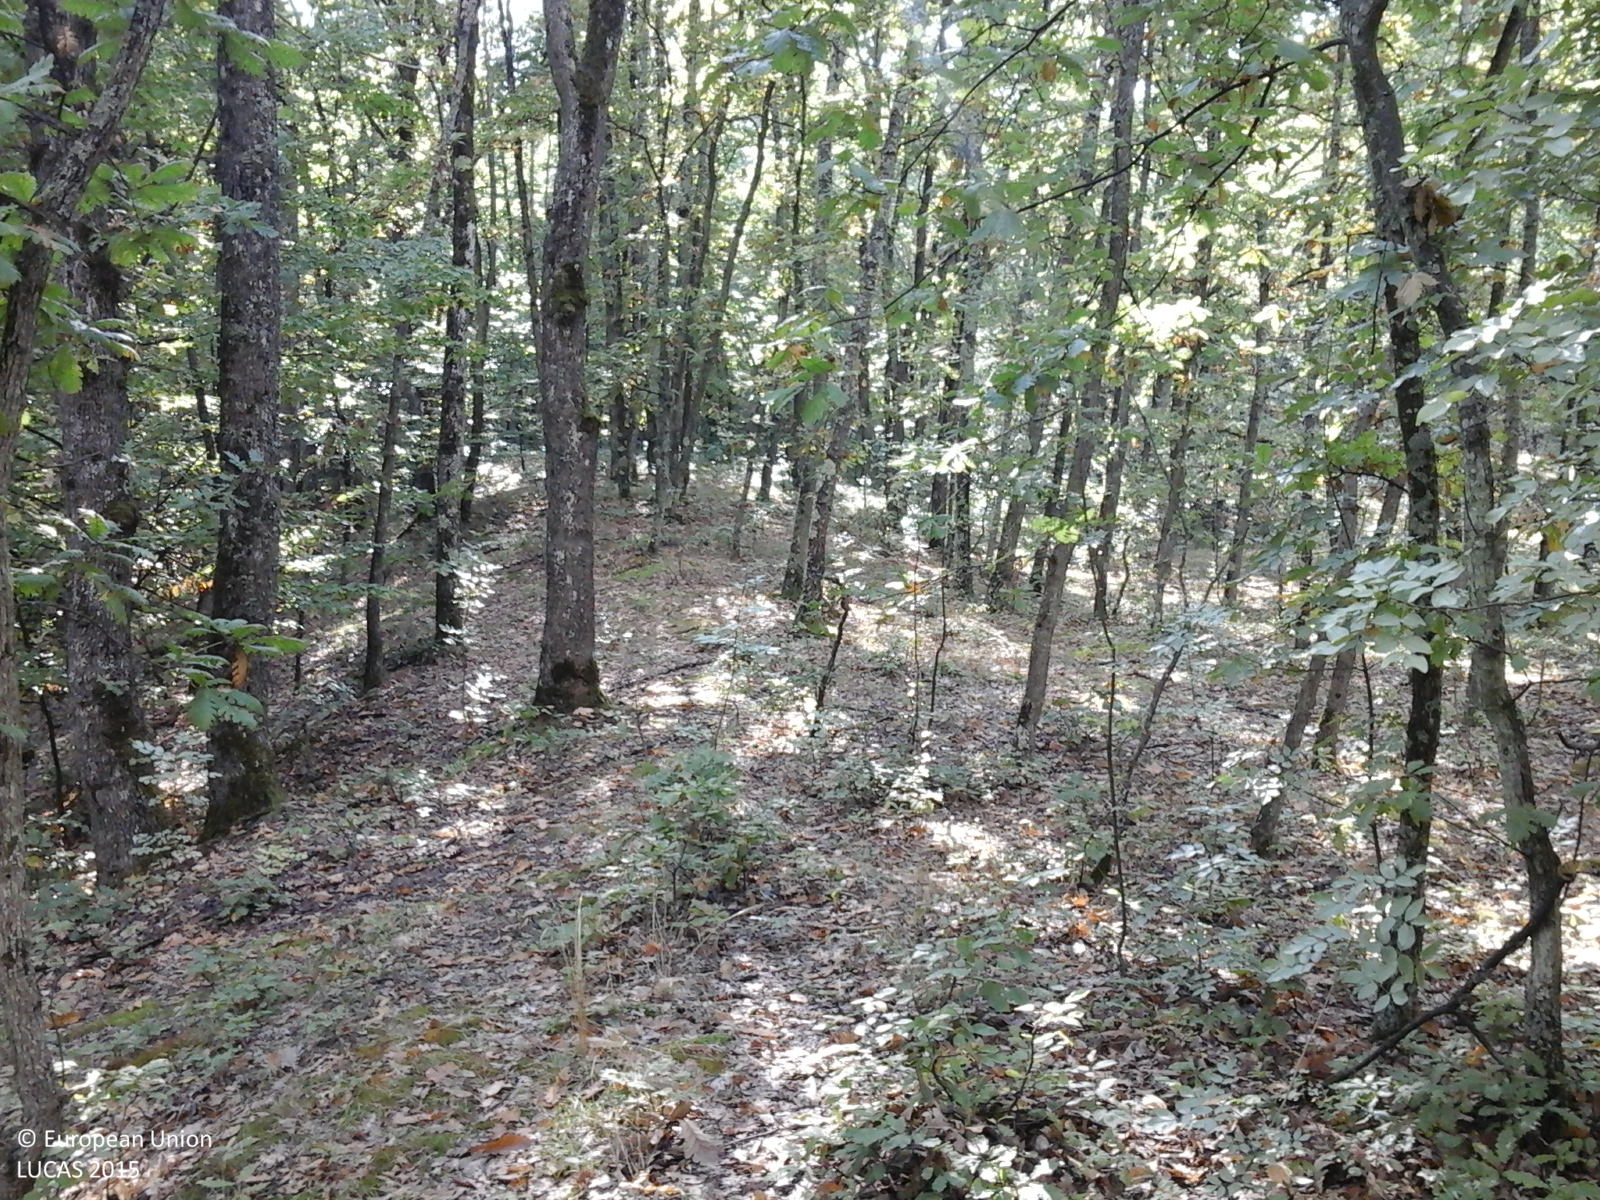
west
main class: Woodland
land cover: Broadleaved woodland
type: acidophilous oak and oak-birch forest
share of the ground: > 75 %
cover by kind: broadleaved forest trees 100 %
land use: Forestry
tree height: > 5 m
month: September
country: RO
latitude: 44.9859
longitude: 23.5912
